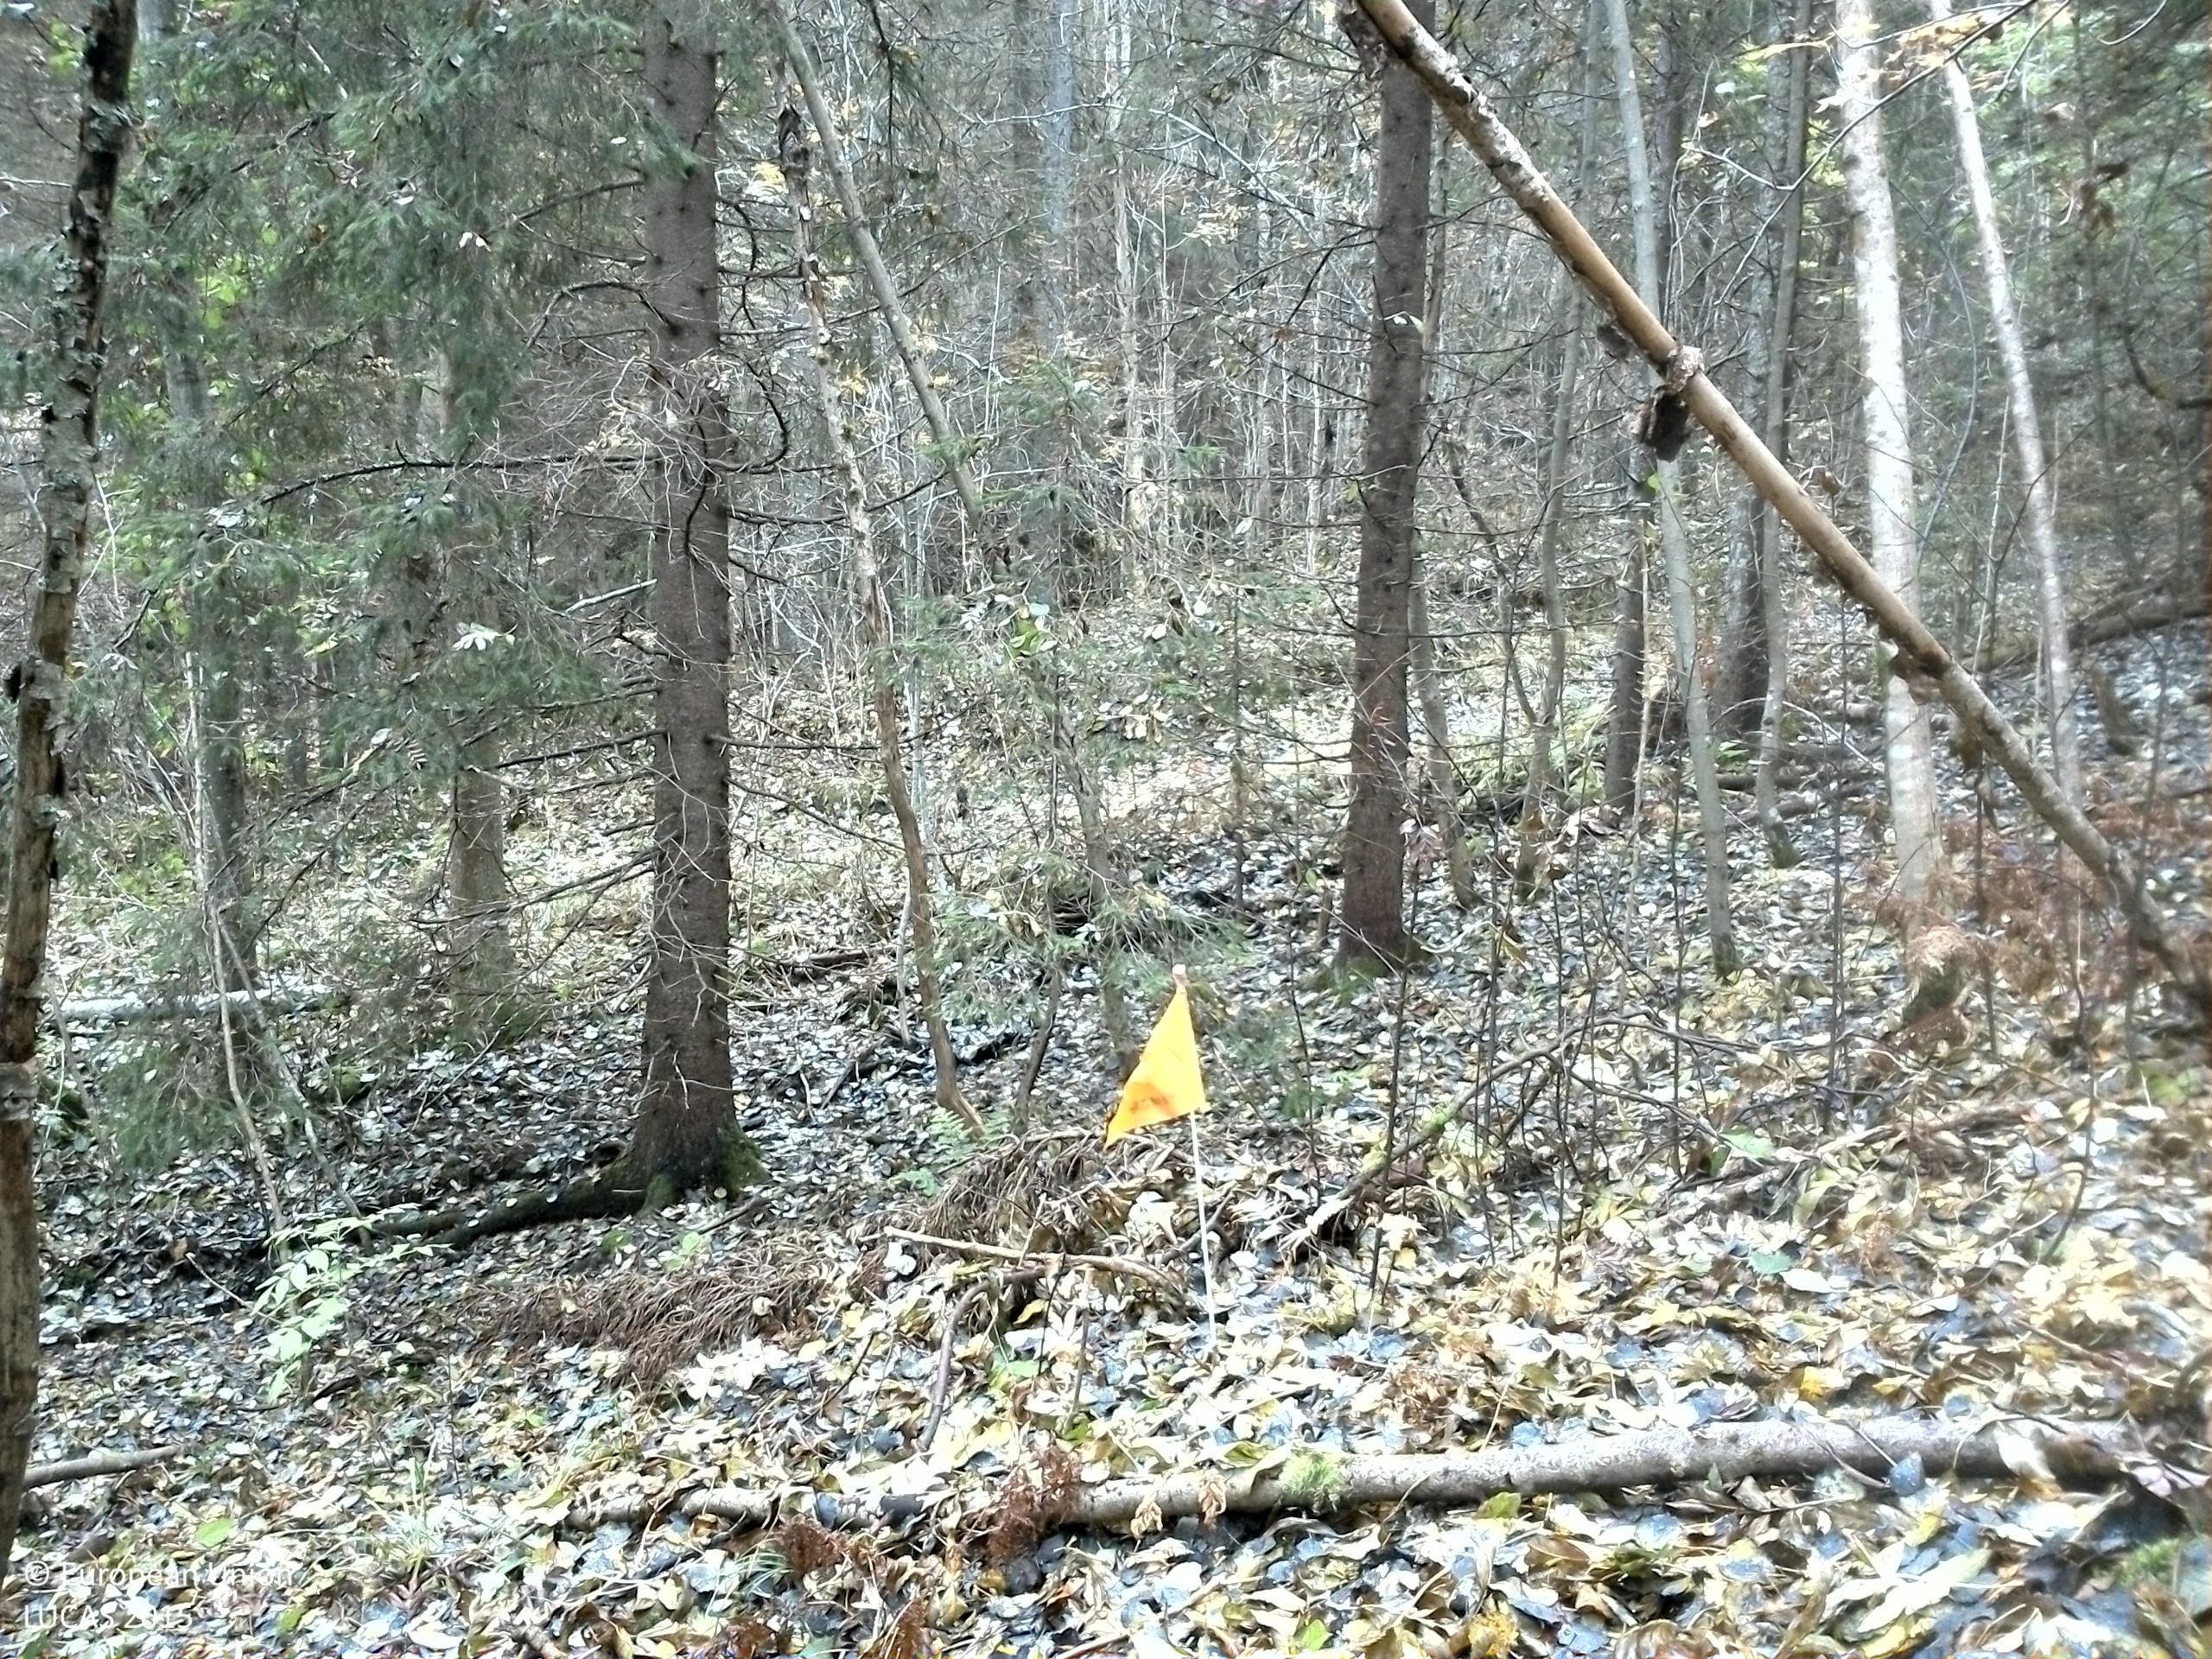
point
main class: Woodland
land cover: Spruce dominated mixed woodland
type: boreal forest
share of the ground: 50 - 75 %
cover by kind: coniferous forest trees 45 %, broadleaved forest trees 20 %, shrubs 15 %, herbaceous plants 10 %, lichens and mosses 10 %
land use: Forestry
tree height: > 5 m
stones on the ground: 10 - 25 %
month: October
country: SE
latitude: 59.7240
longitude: 15.2005
